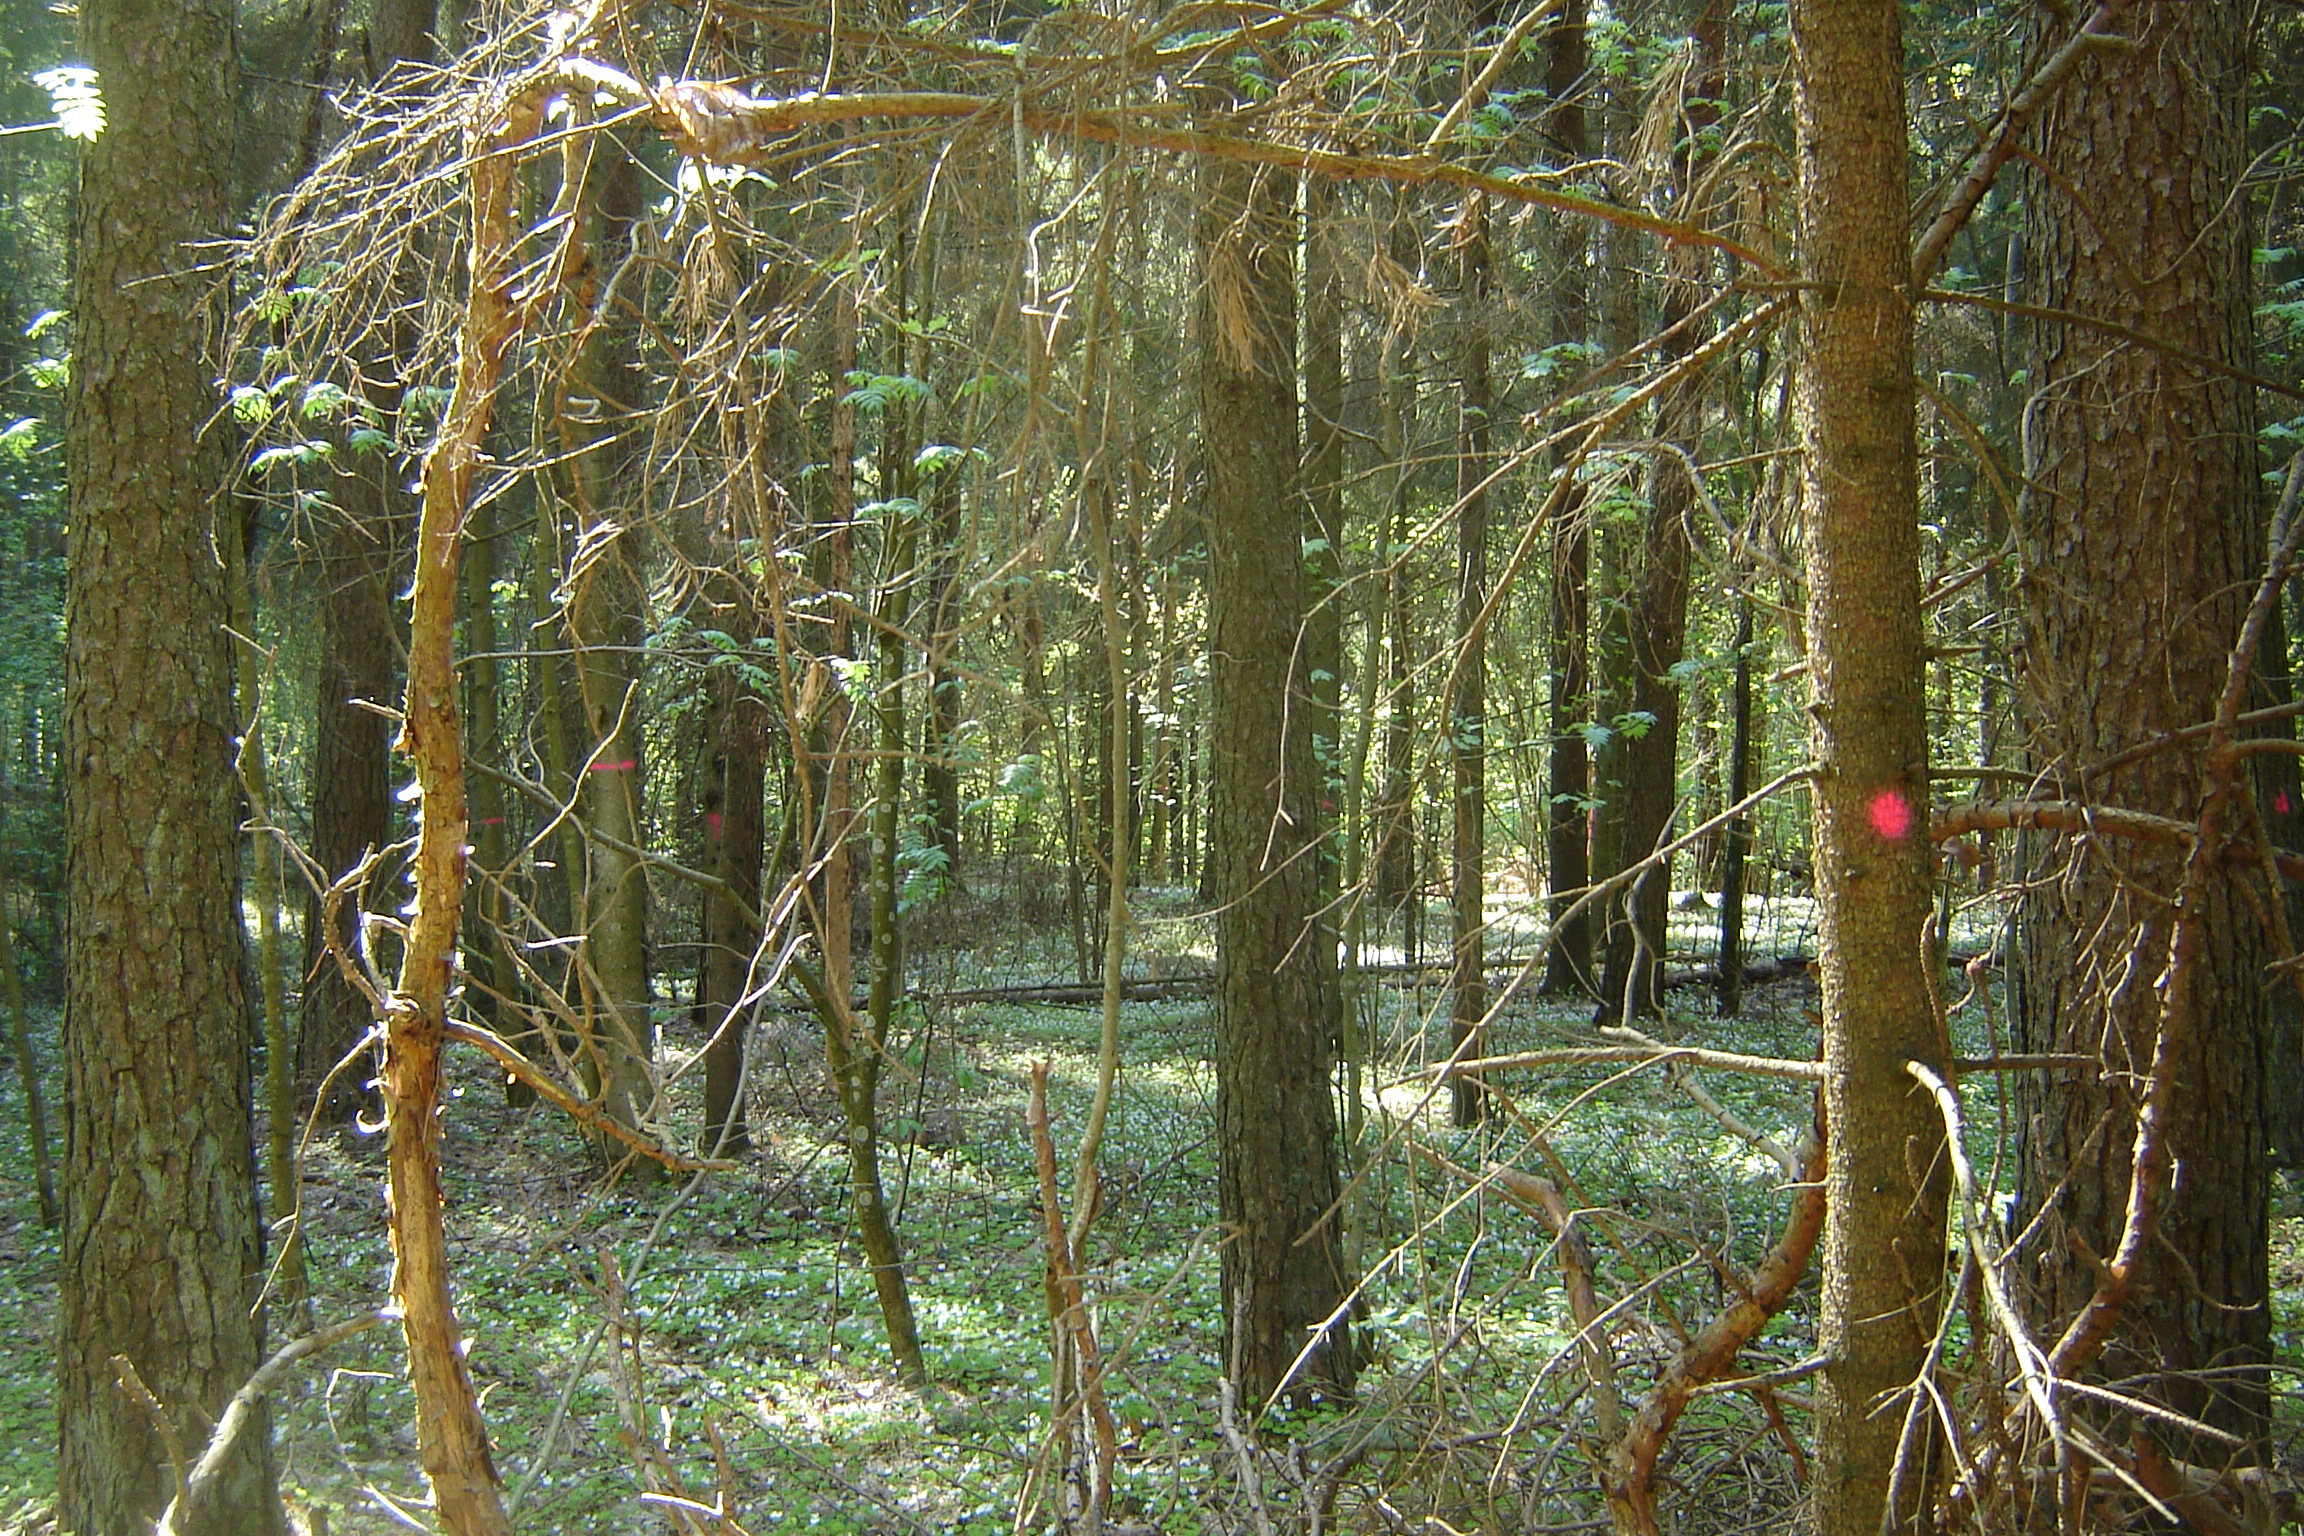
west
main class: Woodland
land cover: Other coniferous woodland
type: hemiboreal forest and nemoral coniferous forest and mixed broadleaved-coniferous forest
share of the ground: > 75 %
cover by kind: coniferous forest trees 100 %
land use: Forestry
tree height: > 5 m
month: May
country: LT
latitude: 56.0195
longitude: 25.7053
